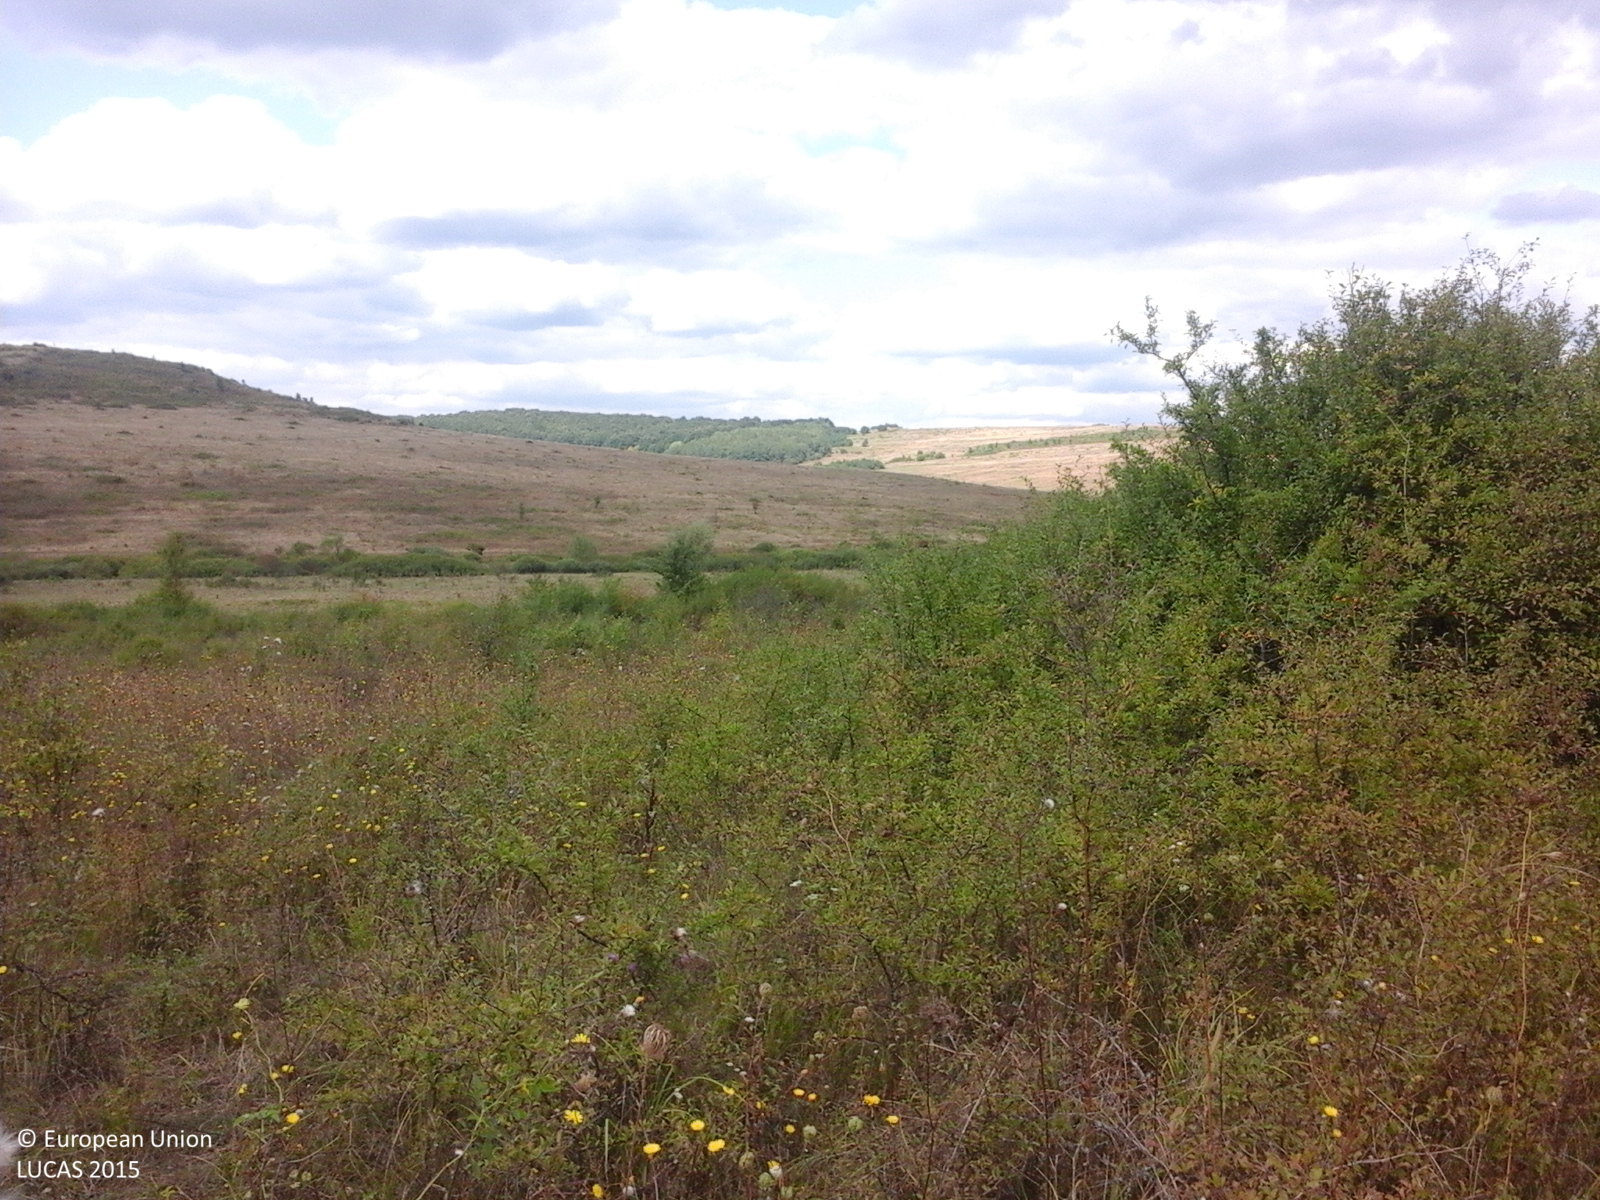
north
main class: Shrubland
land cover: Shrubland without tree cover
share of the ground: > 75 %
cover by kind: shrubs 60 %, herbaceous plants 40 %
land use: Semi-natural and natural areas not in use
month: September
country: RO
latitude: 47.4376
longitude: 23.1006
